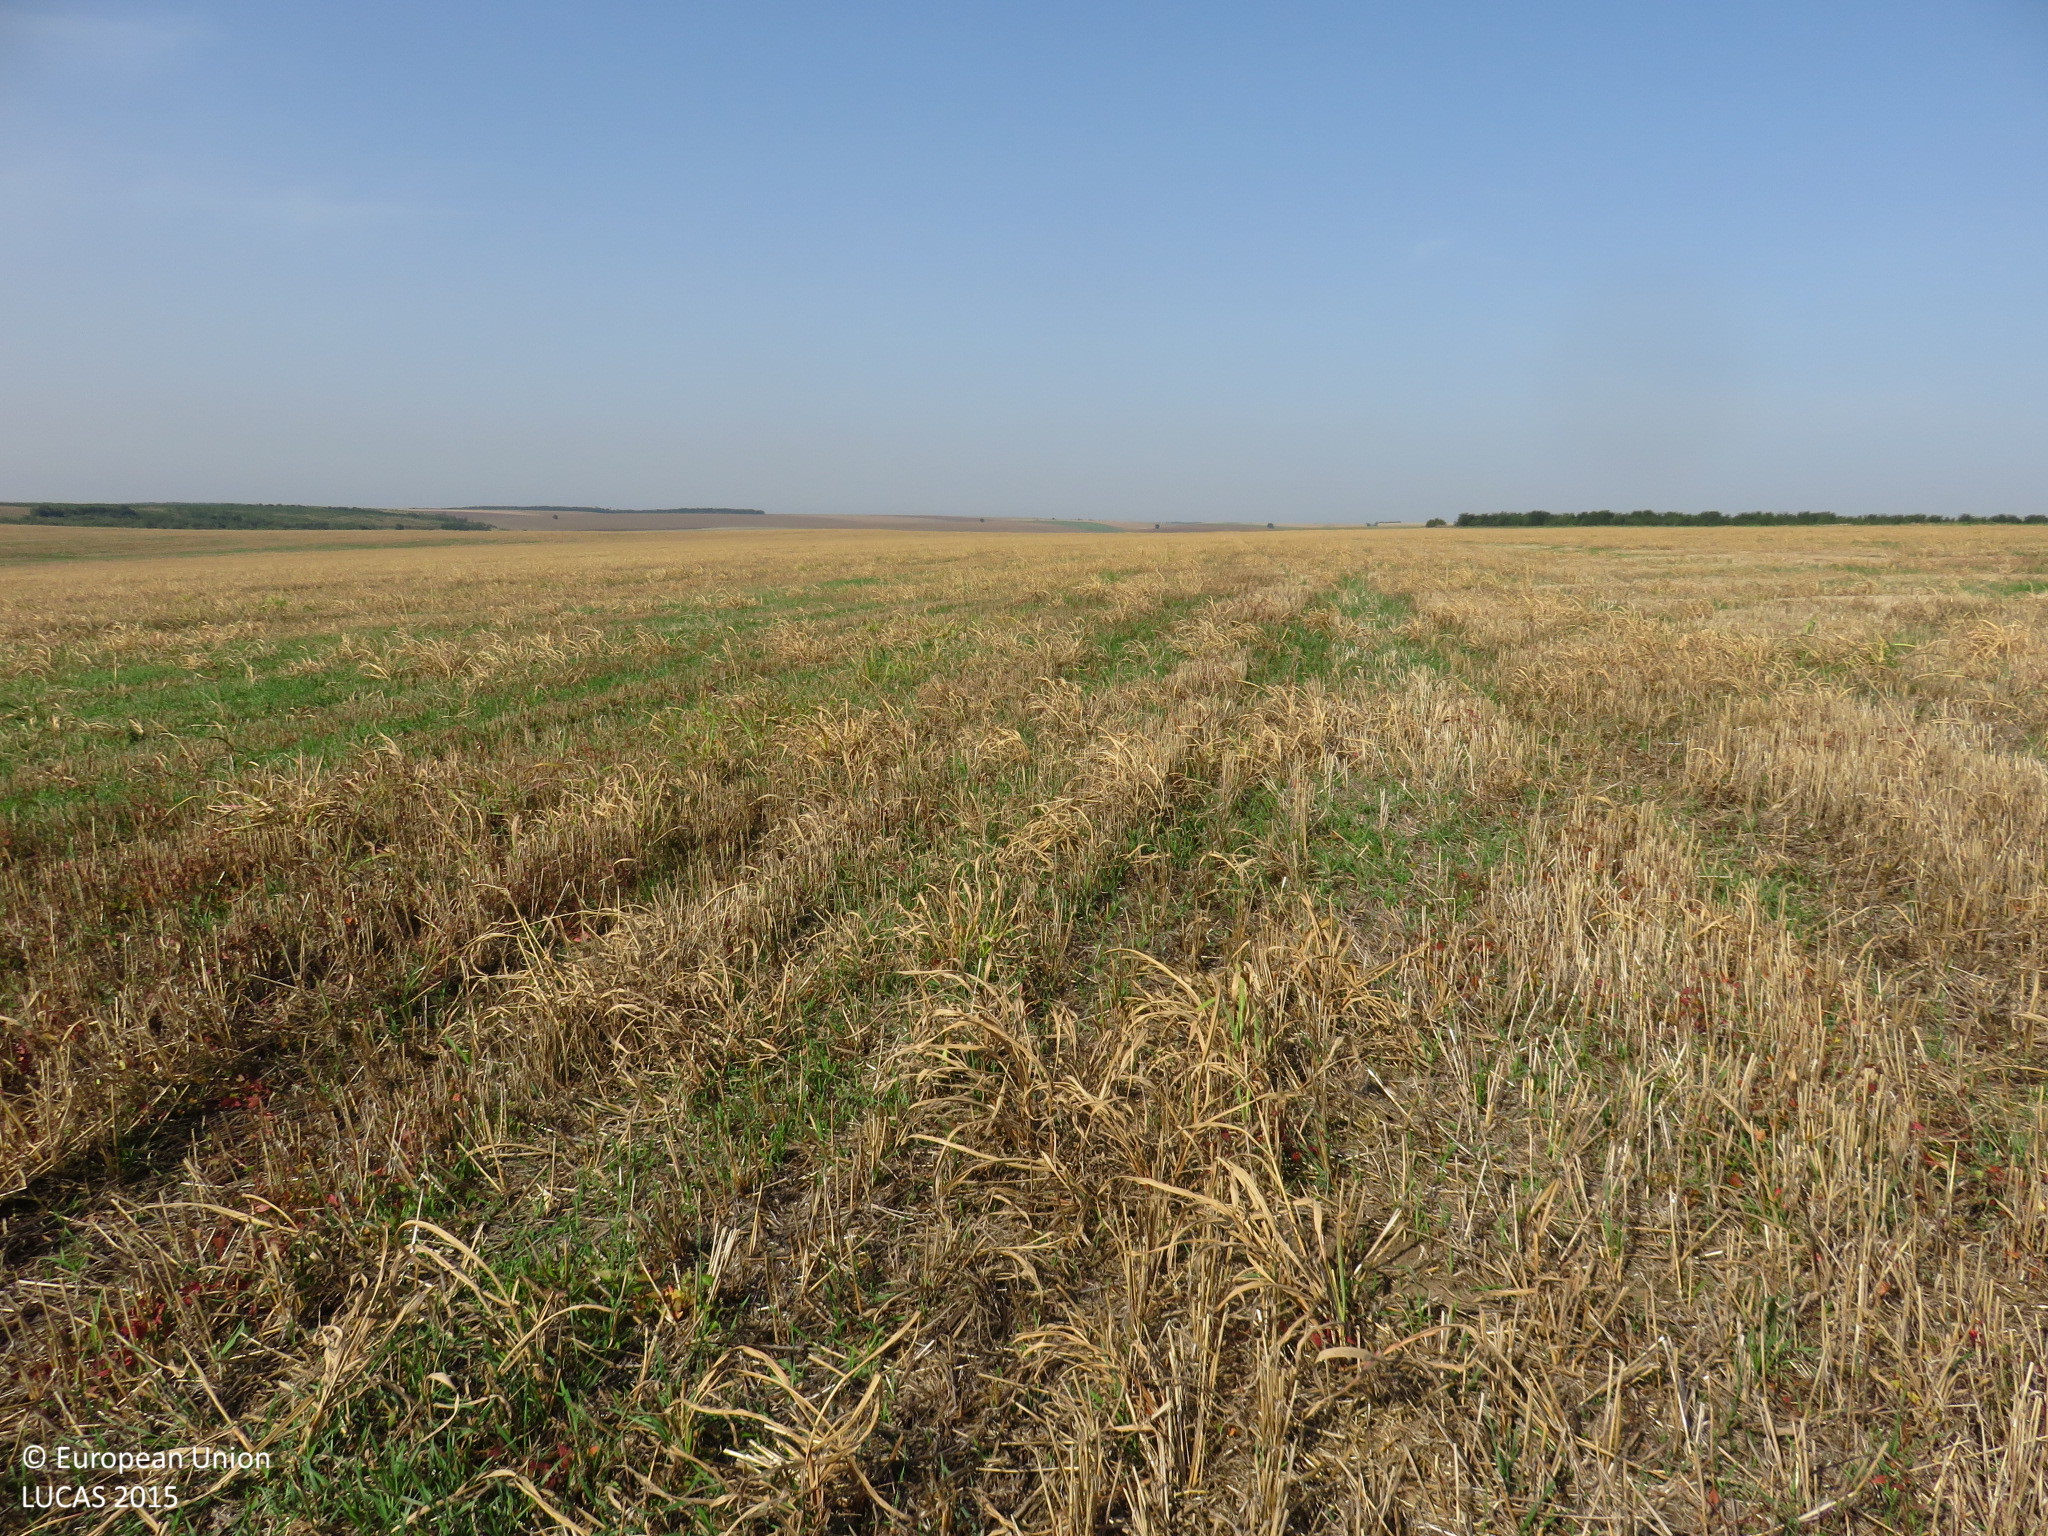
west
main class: Cropland
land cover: Common wheat
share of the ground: > 75 %
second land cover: Spontaneously vegetated surfaces
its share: < 10 %
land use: Agriculture (excluding fallow land and kitchen gardens)
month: September
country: BG
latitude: 43.5941
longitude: 24.5435
